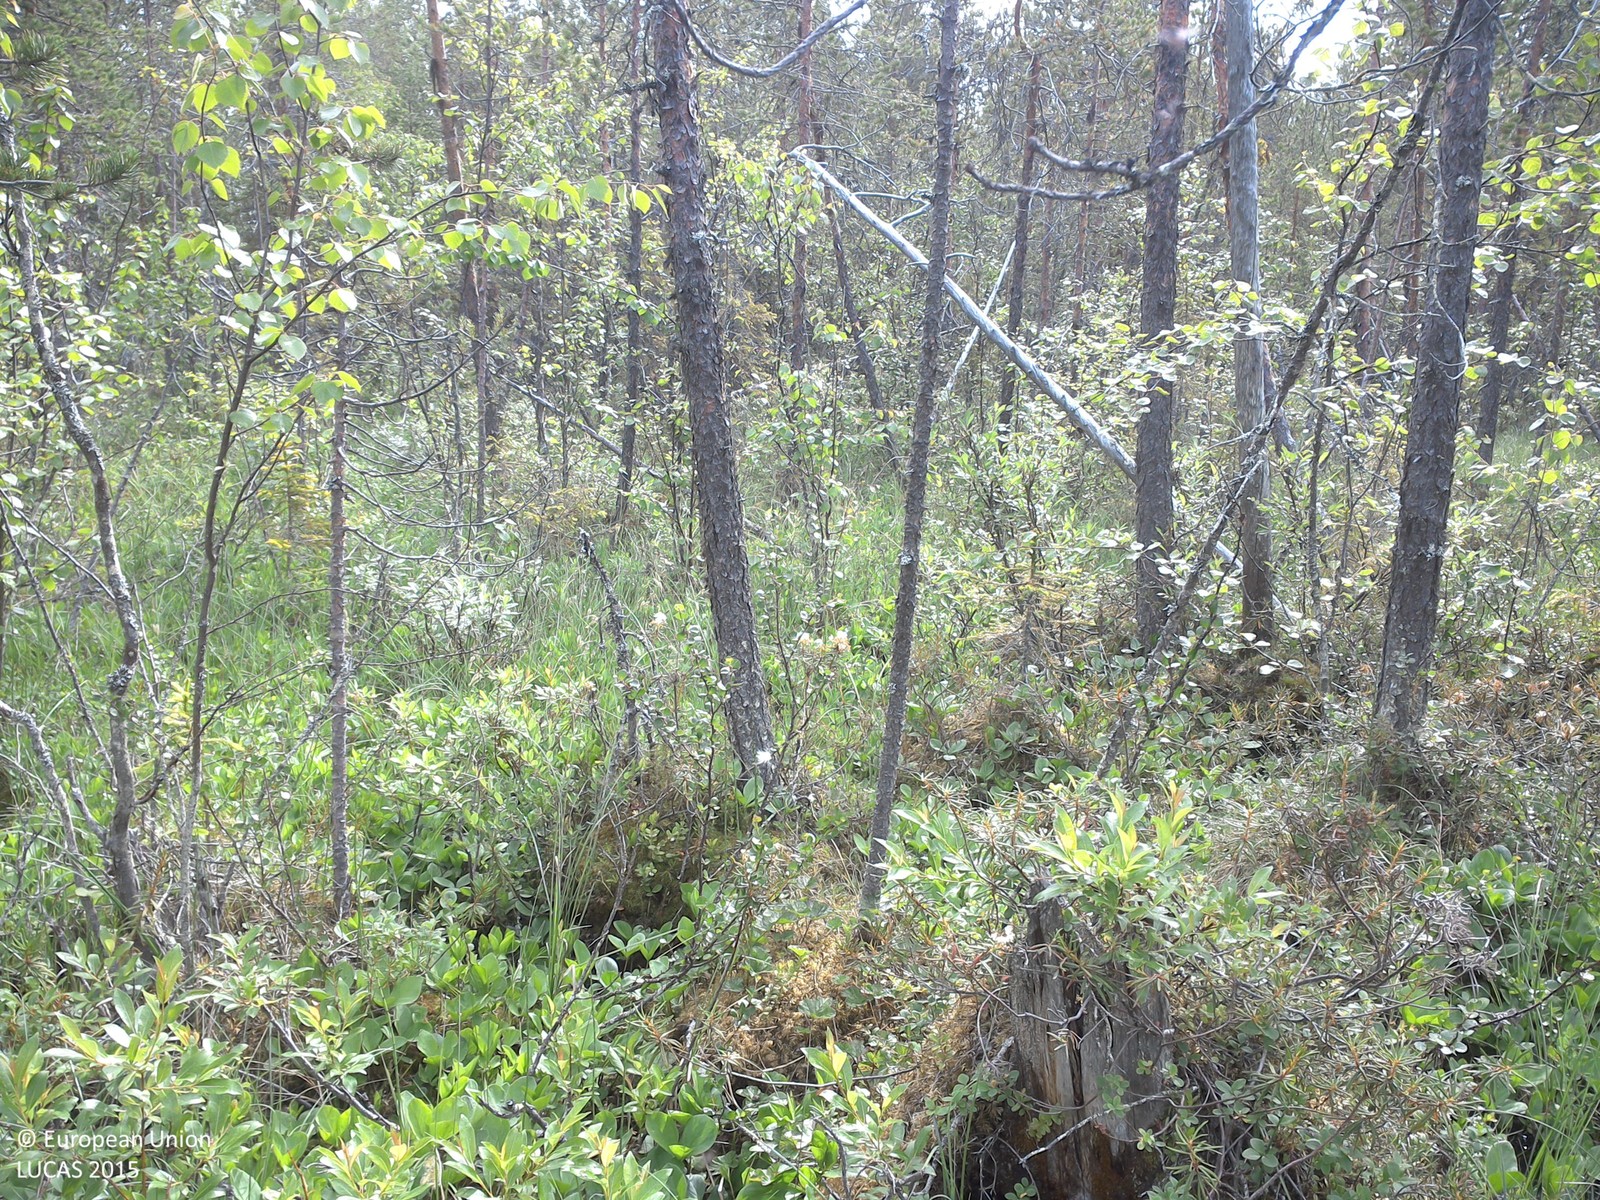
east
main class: Woodland
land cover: Pine dominated mixed woodland
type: boreal forest
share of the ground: 10 - 25 %
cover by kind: herbaceous plants 50 %, coniferous forest trees 15 %, shrubs 15 %, lichens and mosses 10 %, broadleaved forest trees 5 %
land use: Forestry
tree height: > 5 m
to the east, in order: Pine dominated mixed woodland; Ditches and canals; Groves; Tracks; Other mixed woodland; Ditches and canals; Groves; Spruce dominated mixed woodland; Pine dominated mixed woodland; Lichens and moss; Pine dominated mixed woodland
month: July
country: SE
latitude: 67.2988
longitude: 22.7575
